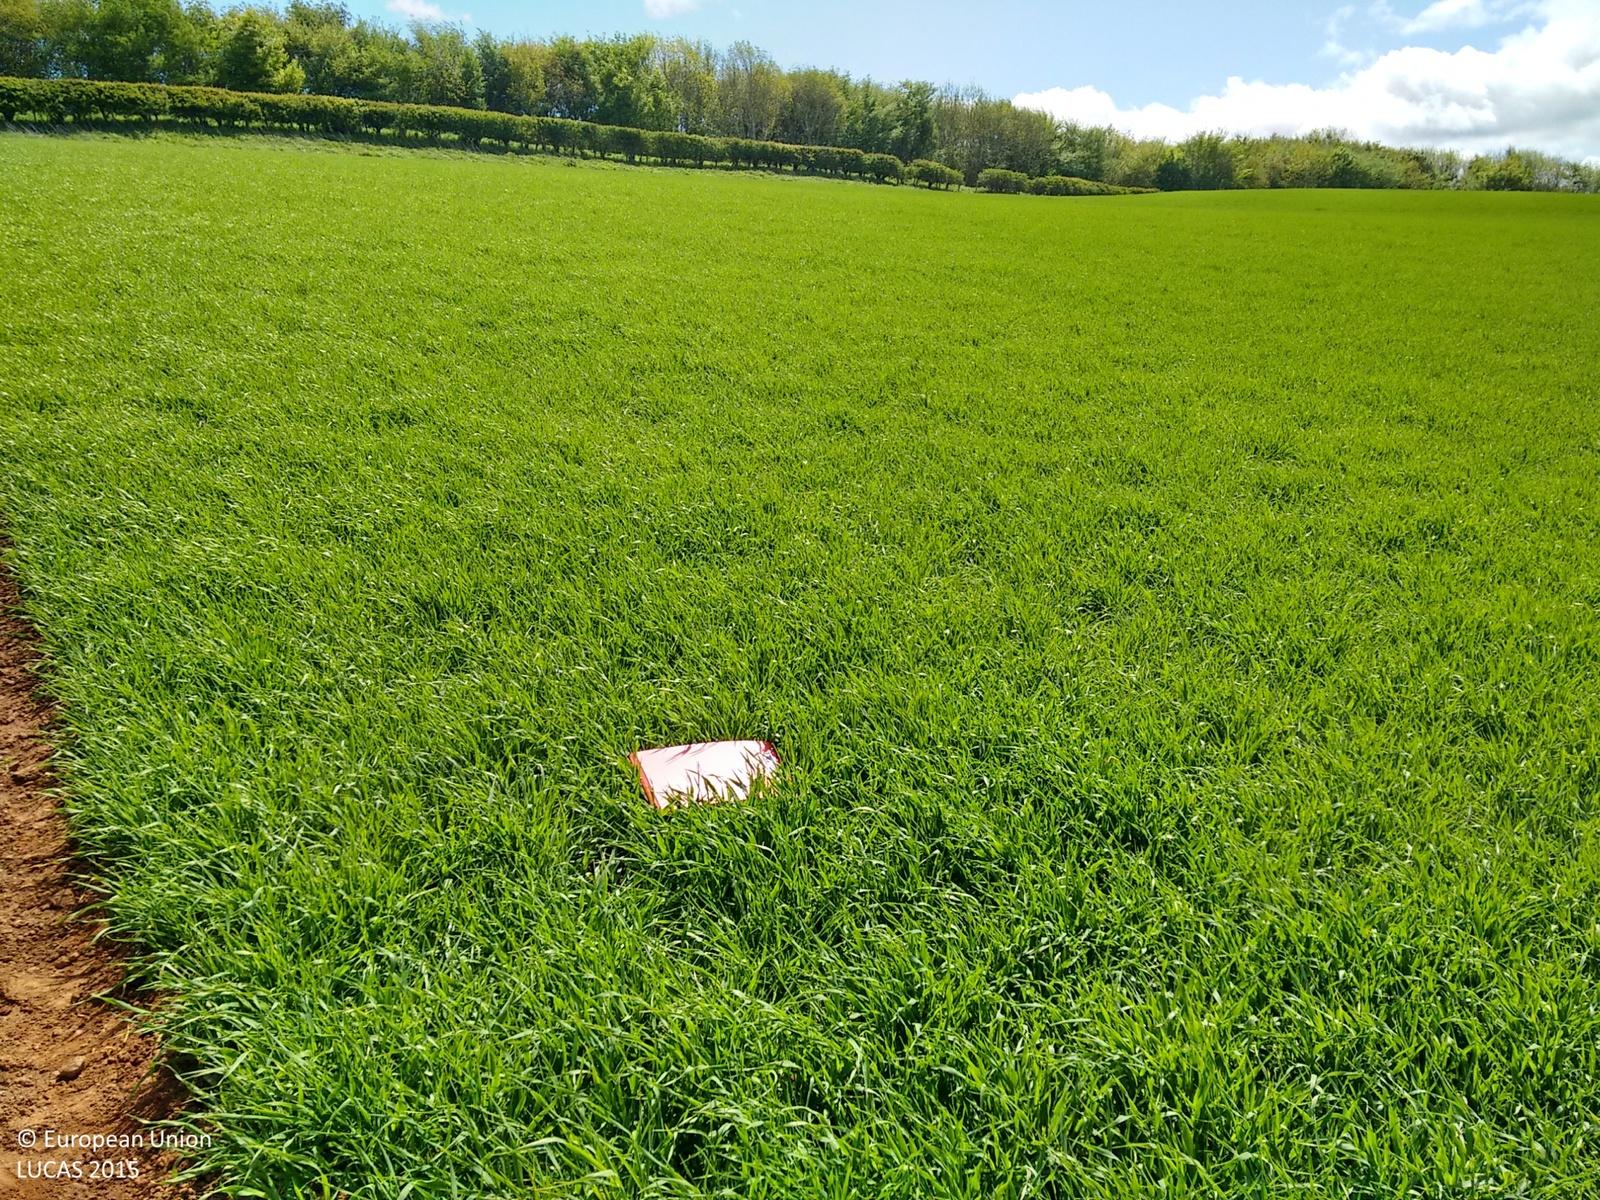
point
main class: Cropland
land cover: Barley
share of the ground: > 75 %
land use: Agriculture (excluding fallow land and kitchen gardens)
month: May
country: GB
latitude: 55.5879
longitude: -2.3546
